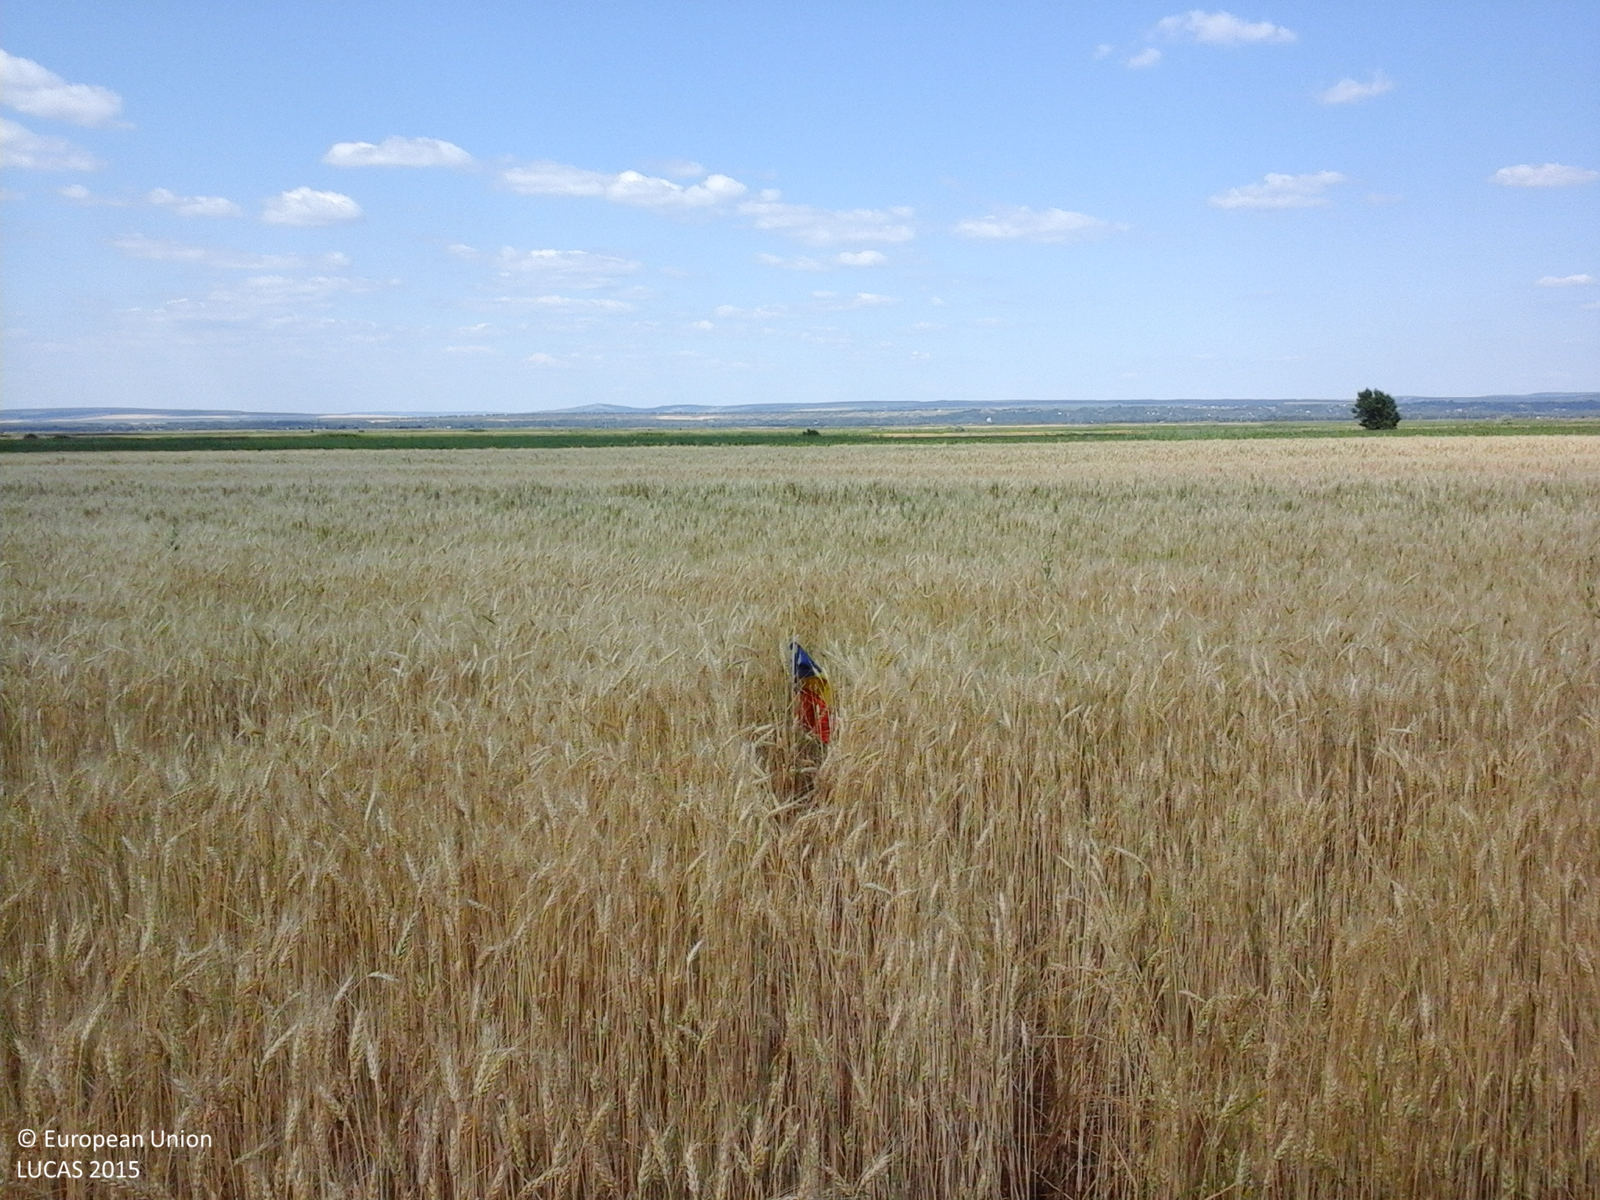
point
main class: Cropland
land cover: Durum wheat
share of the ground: > 75 %
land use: Agriculture (excluding fallow land and kitchen gardens)
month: June
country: RO
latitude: 47.0488
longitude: 27.8297
